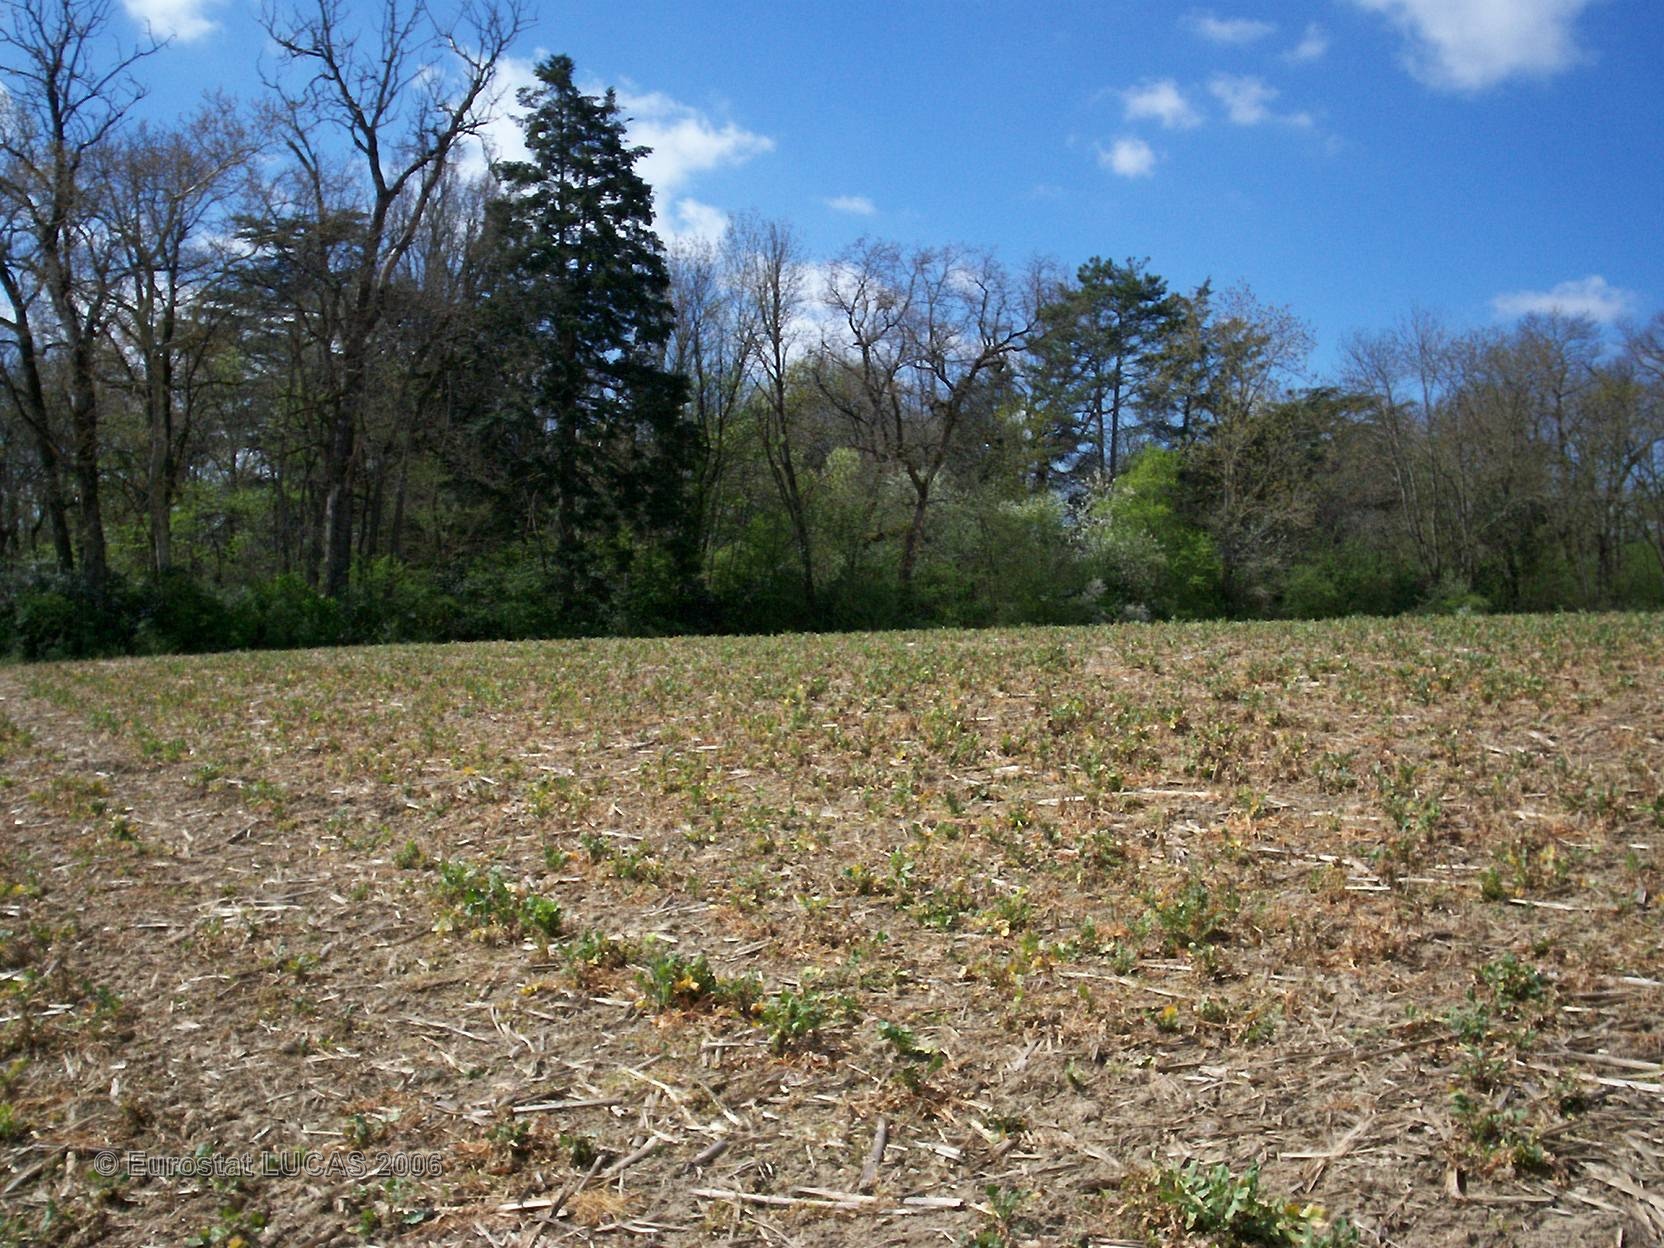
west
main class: Grassland
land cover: Grassland without tree/shrub cover
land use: Agriculture (excluding fallow land and kitchen gardens)
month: April
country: FR
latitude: 43.5556
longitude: 2.0457
